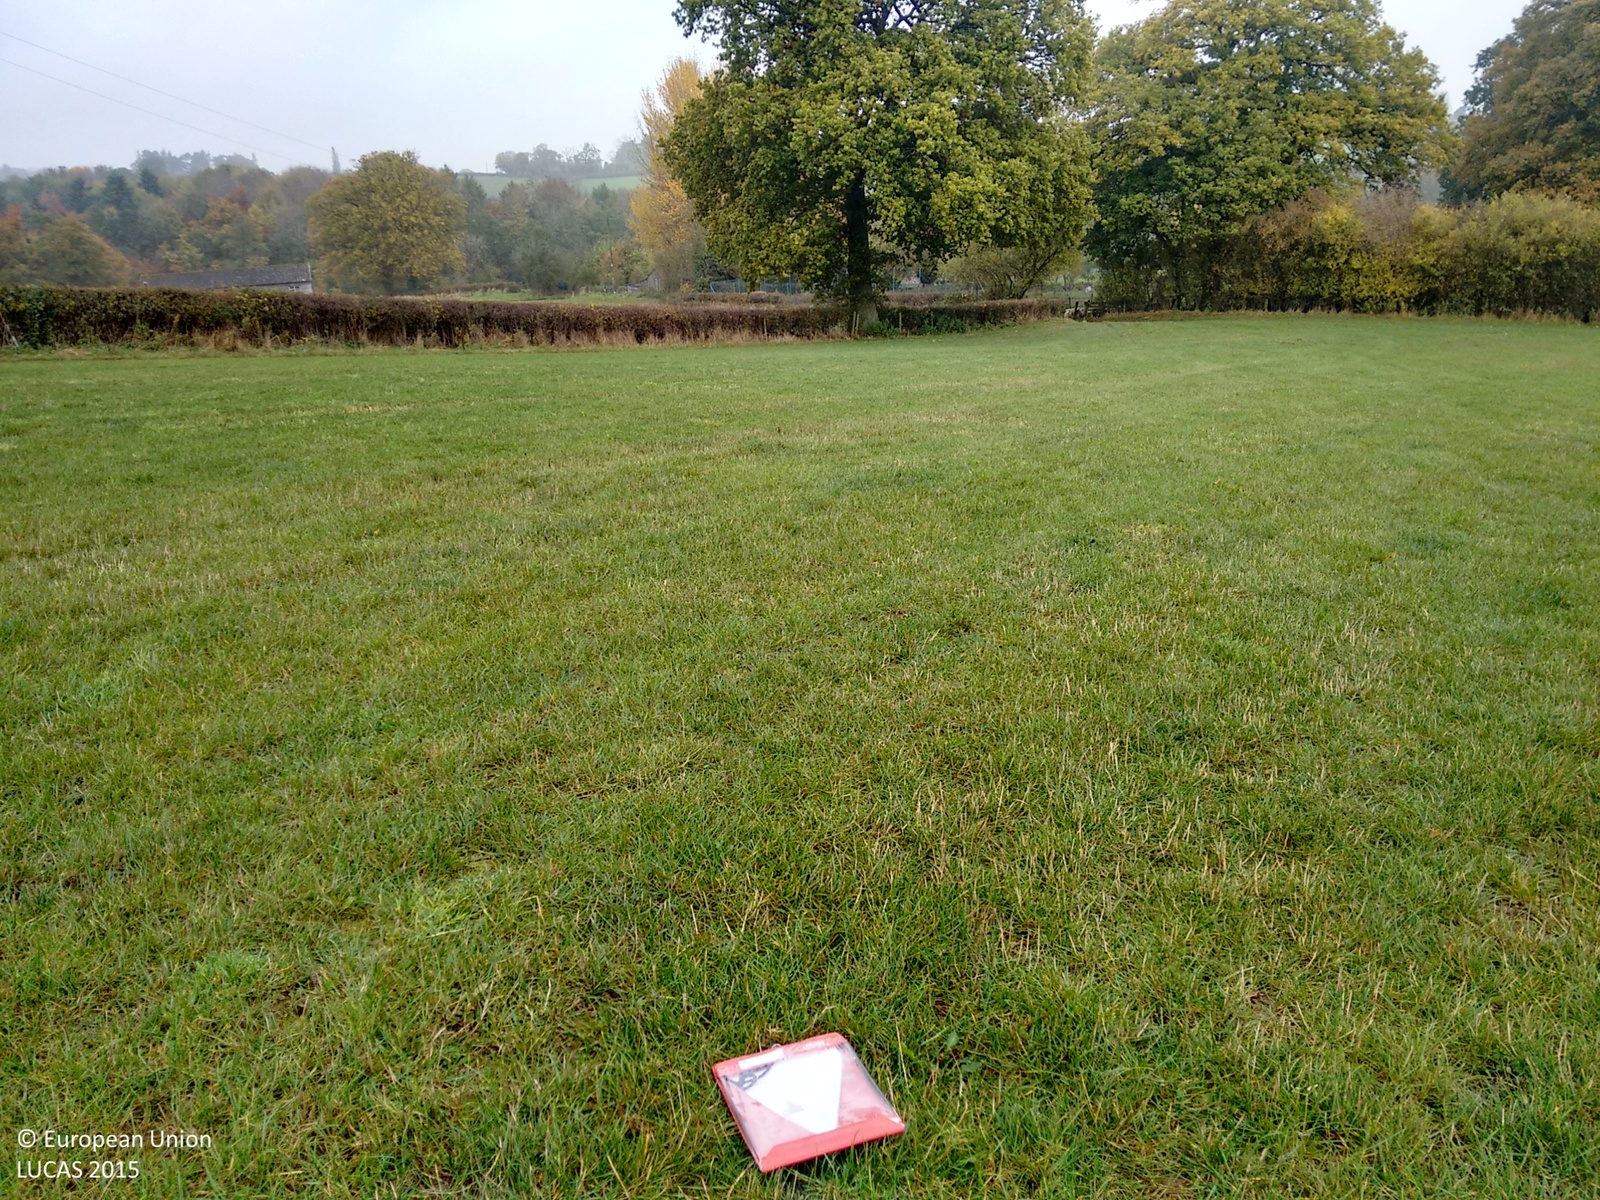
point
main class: Grassland
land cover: Grassland without tree/shrub cover
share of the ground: > 75 %
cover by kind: herbaceous plants 100 %
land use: Agriculture (excluding fallow land and kitchen gardens)
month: October
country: GB
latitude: 52.4626
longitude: -2.4734
